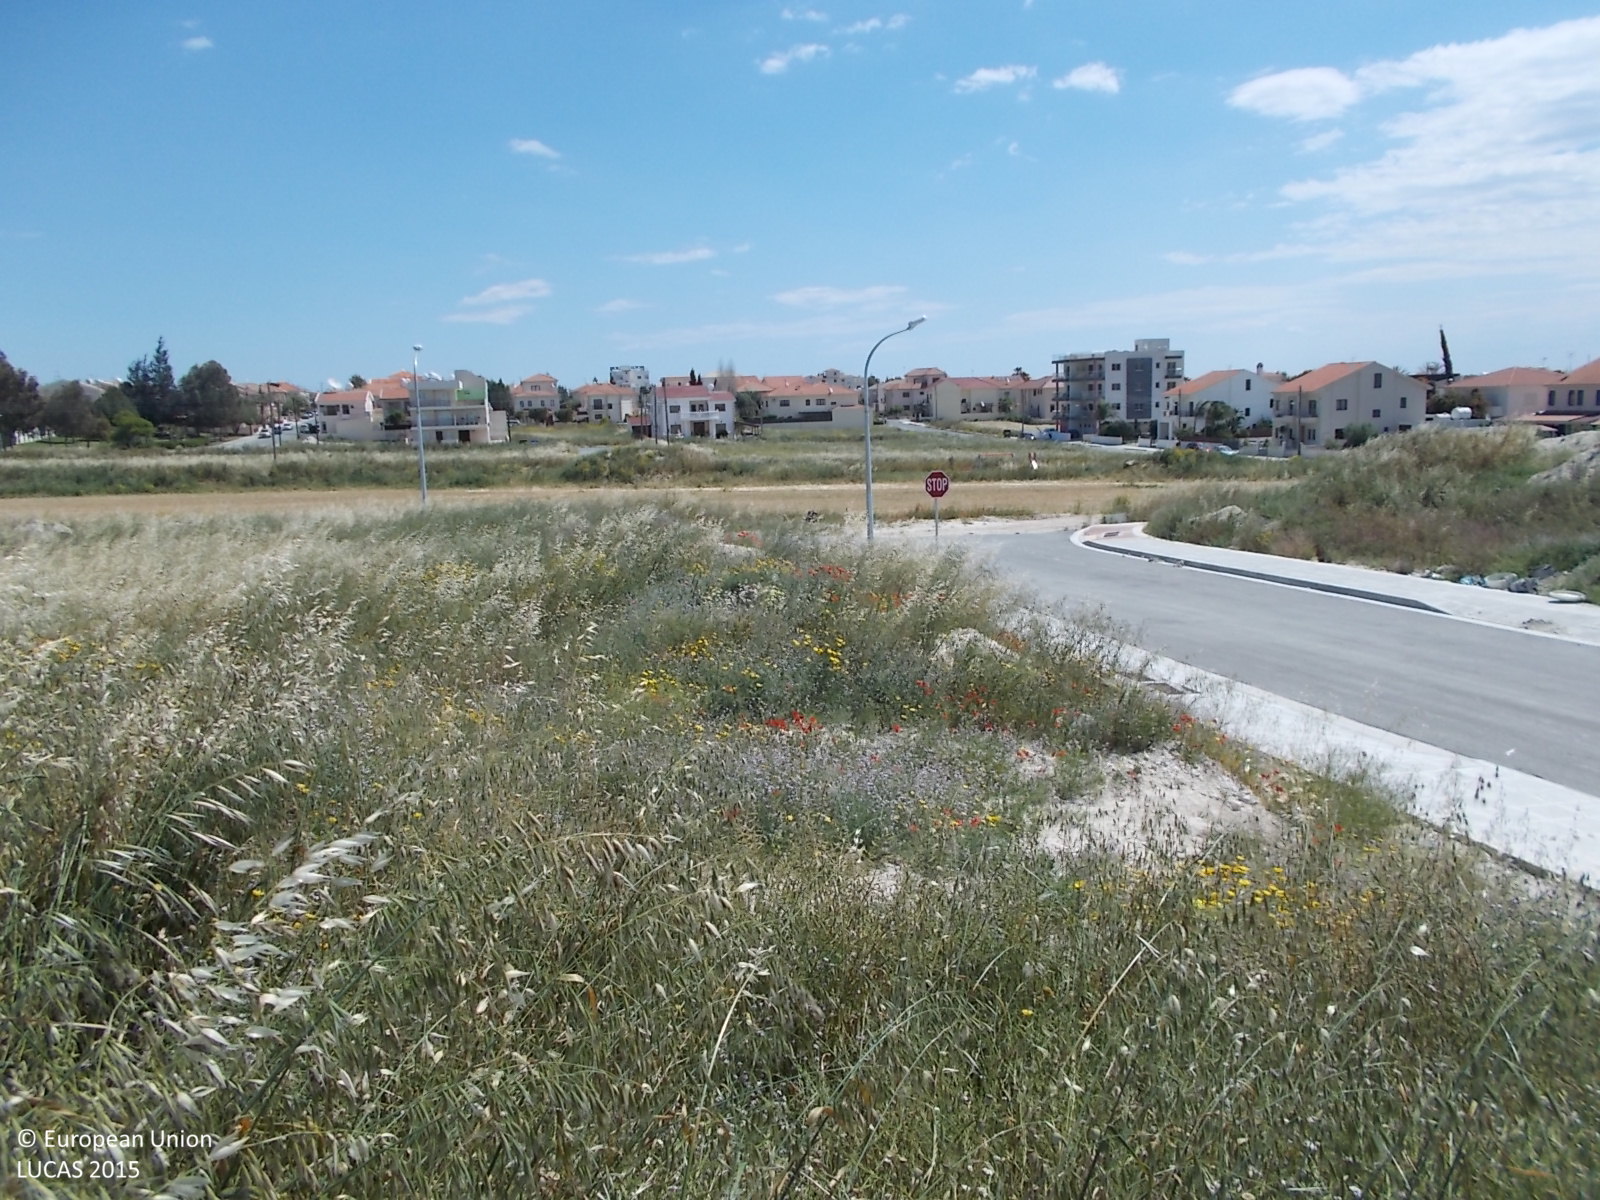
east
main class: Grassland
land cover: Spontaneously vegetated surfaces
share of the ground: > 75 %
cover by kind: herbaceous plants 100 %
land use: Residential
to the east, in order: Spontaneously vegetated surfaces; Paved roads, cycling and walking lanes; Spontaneously vegetated surfaces; Common wheat; Spontaneously vegetated surfaces; Mixed cereals for fodder; Spontaneously vegetated surfaces; Artificial constructions in urban areas
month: April
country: CY
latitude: 34.9060
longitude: 33.5820
